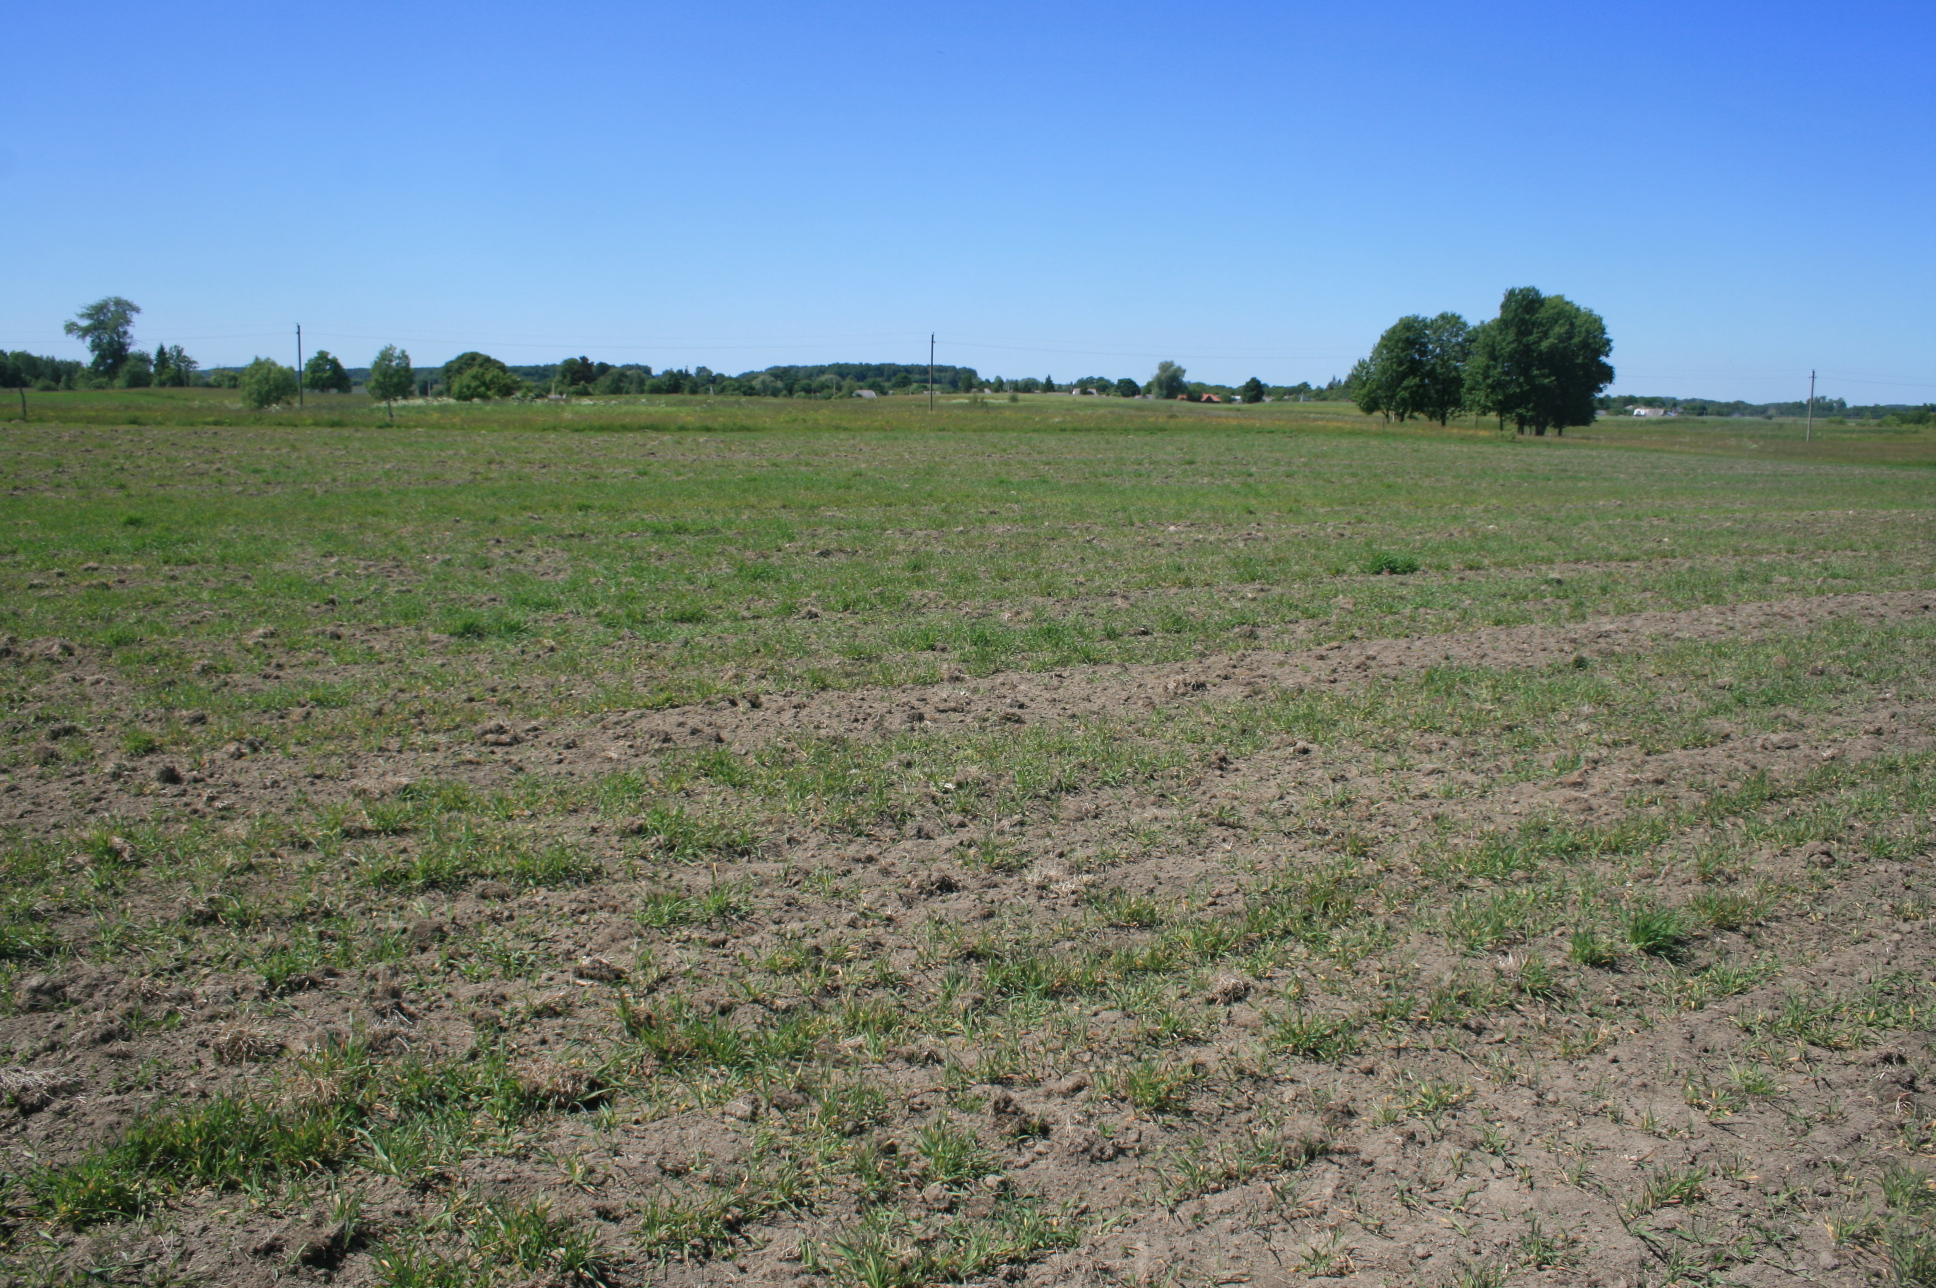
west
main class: Cropland
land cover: Barley
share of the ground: 25 - 50 %
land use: Agriculture (excluding fallow land and kitchen gardens)
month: June
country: LT
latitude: 55.5325
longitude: 22.1761
